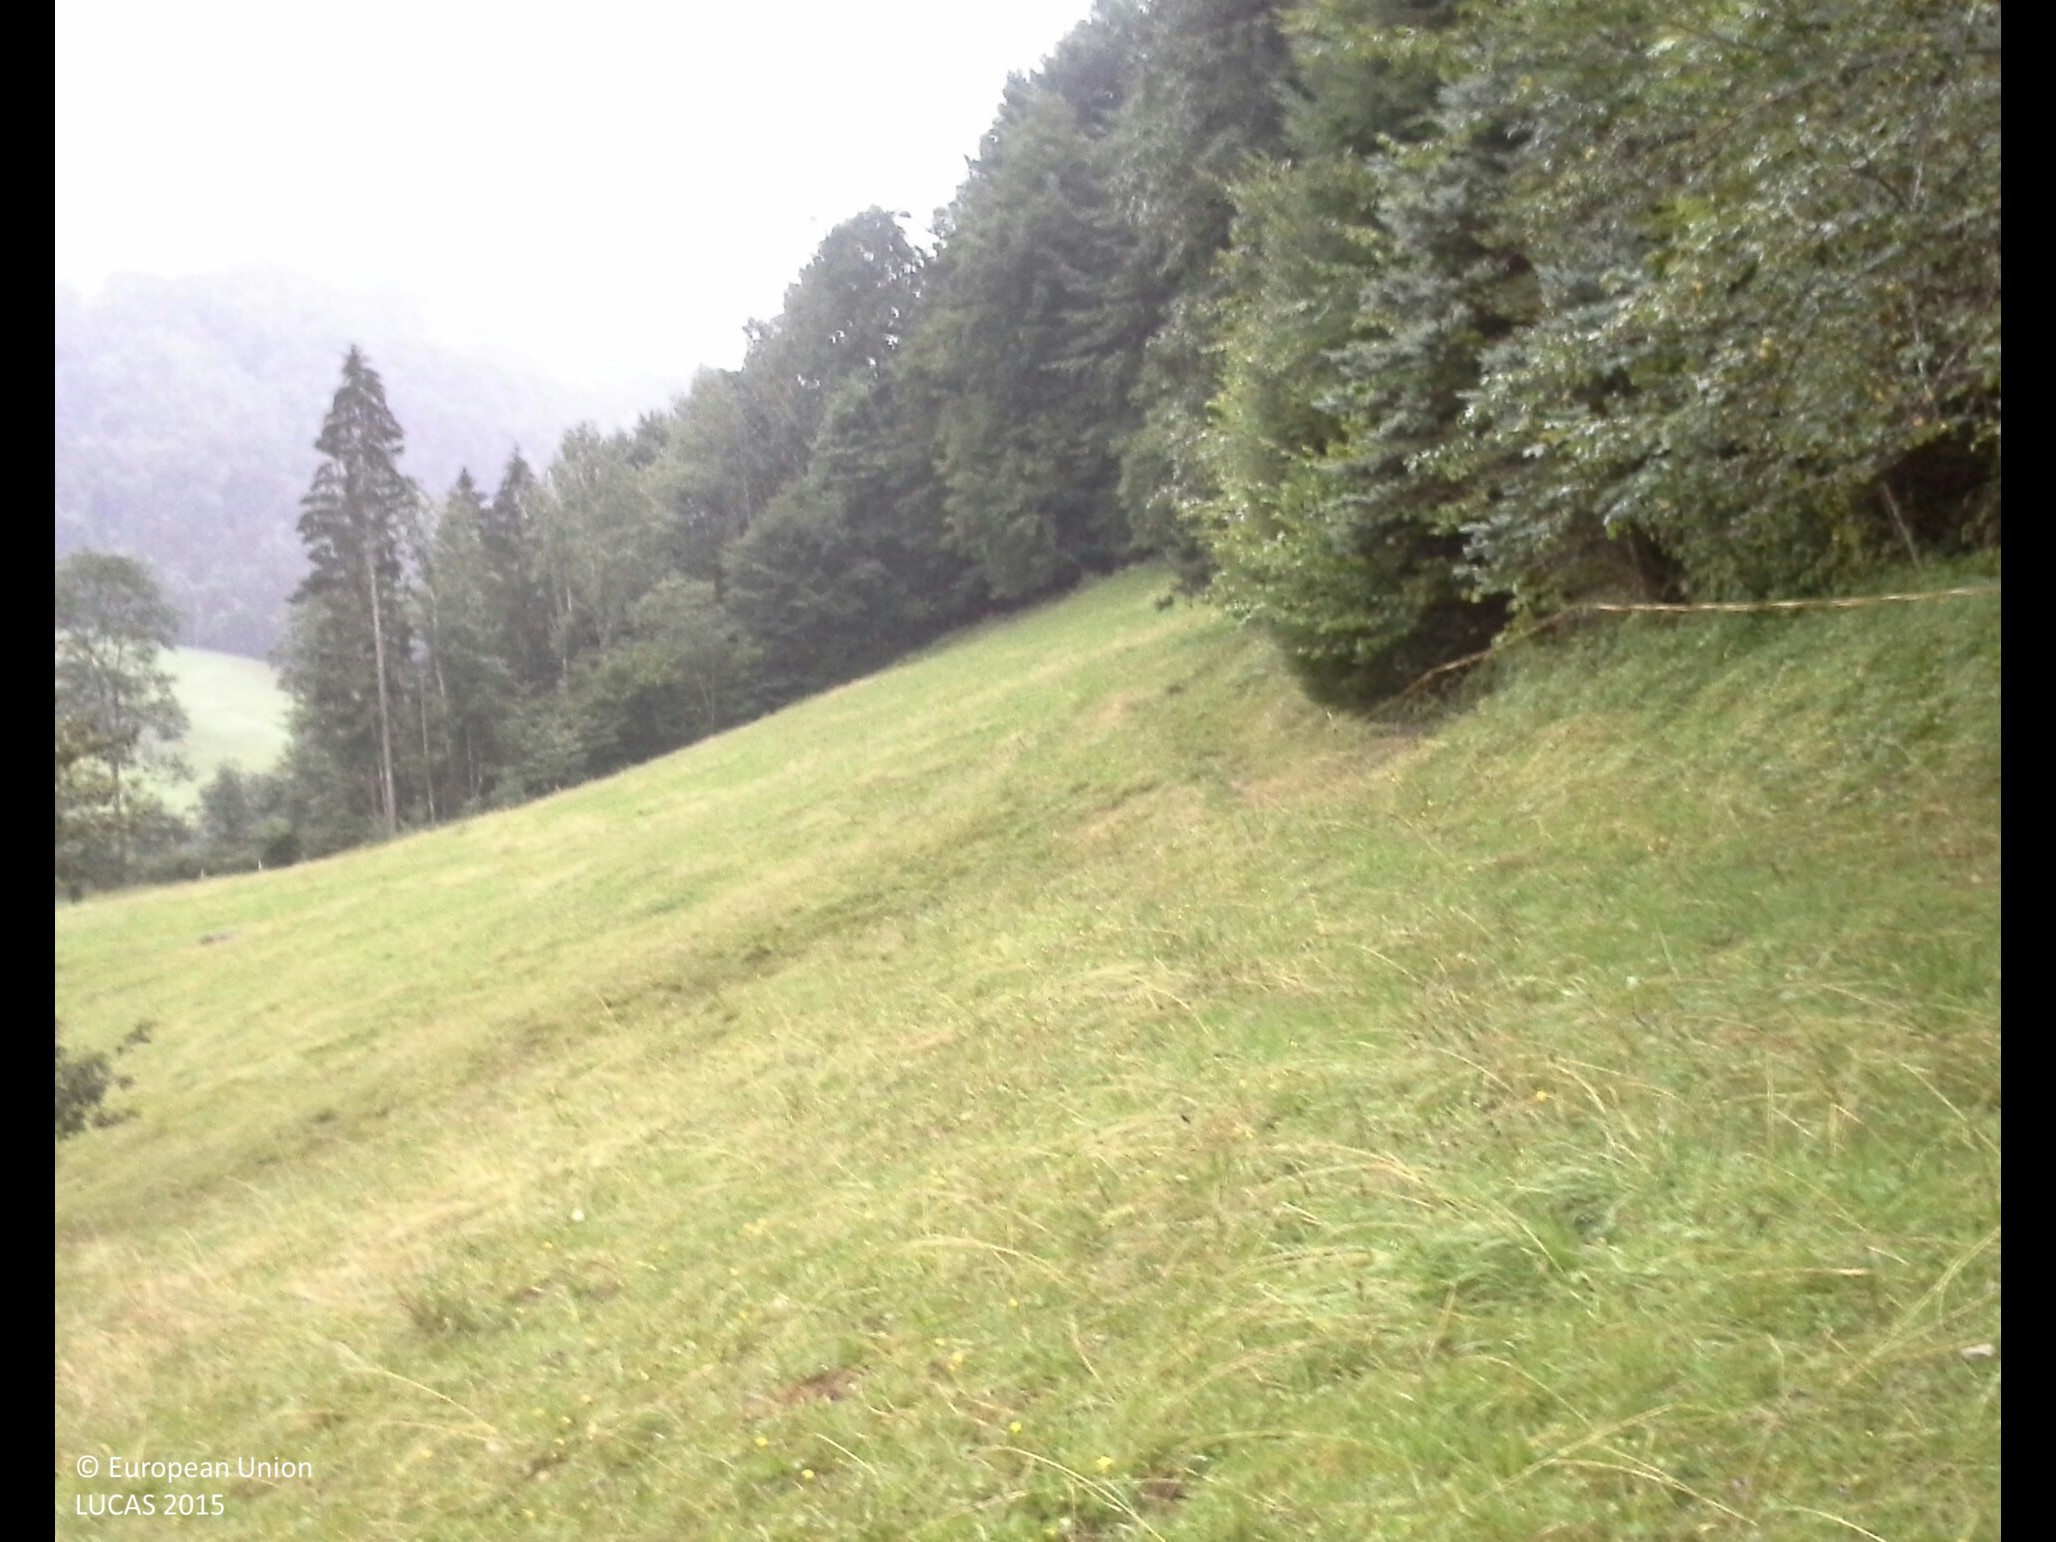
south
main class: Grassland
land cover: Grassland without tree/shrub cover
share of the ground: > 75 %
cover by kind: herbaceous plants 95 %, unconsolidated bare surface 5 %
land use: Agriculture (excluding fallow land and kitchen gardens)
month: July
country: AT
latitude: 47.8069
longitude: 14.9276
